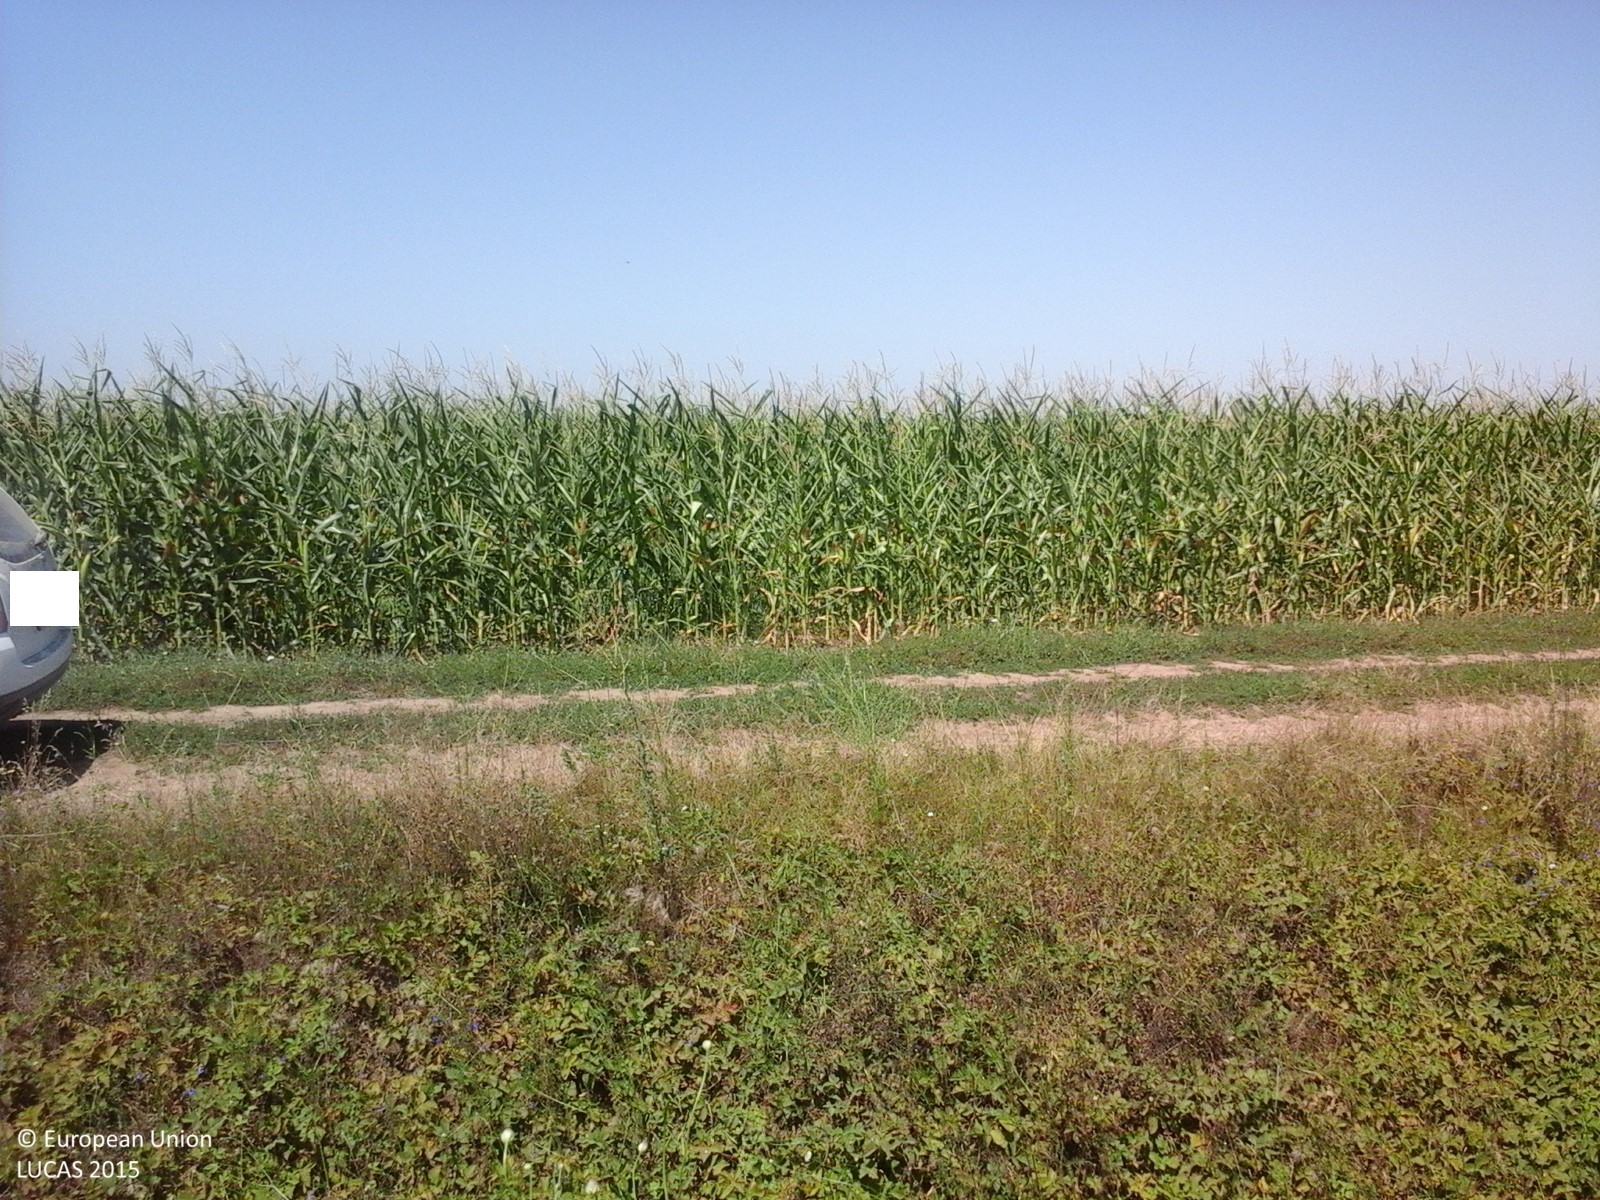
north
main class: Cropland
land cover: Sunflower
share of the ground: > 75 %
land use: Agriculture (excluding fallow land and kitchen gardens)
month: July
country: RO
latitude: 44.2530
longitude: 26.4817
